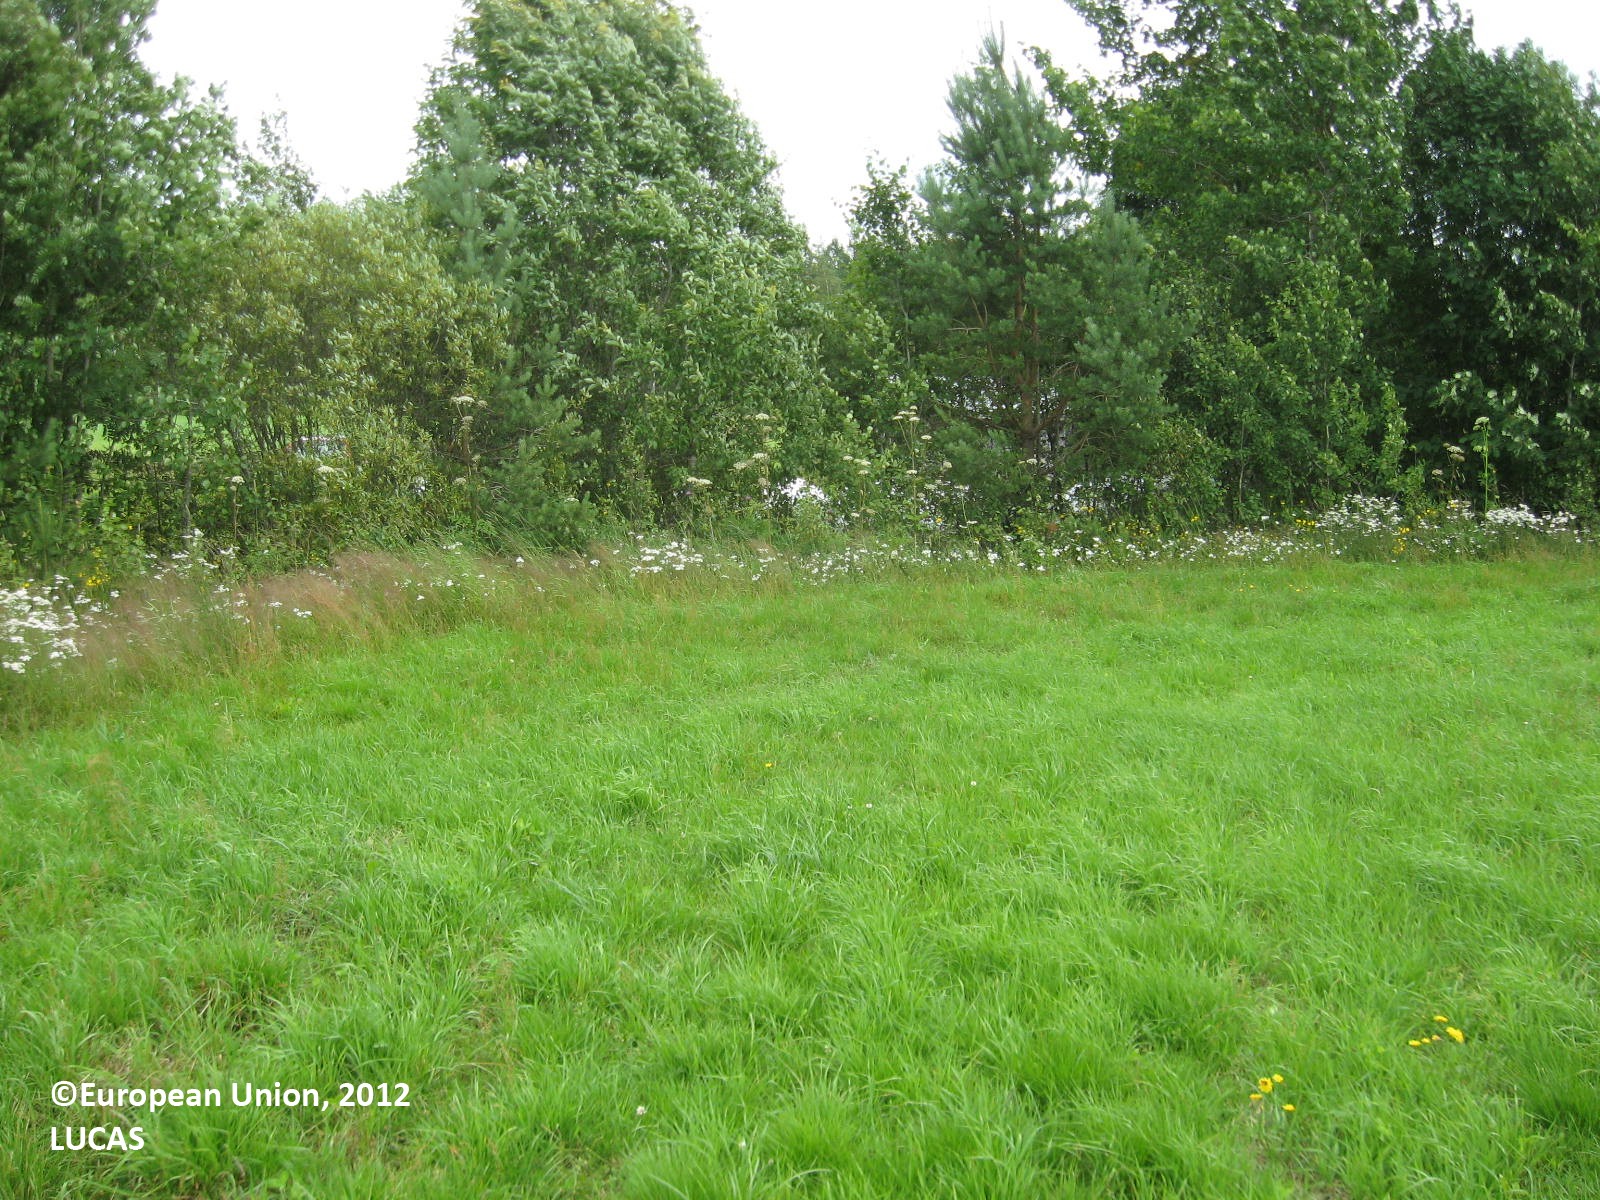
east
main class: Cropland
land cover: Temporary grasslands
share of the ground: > 75 %
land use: Agriculture (excluding fallow land and kitchen gardens)
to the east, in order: Temporary grasslands; Grass margins; Broadleaved woodland; Ditches and canals; Shruby margins; Temporary grasslands; Shruby margins; Temporary grasslands; Shruby margins; Ditches and canals; Pine dominated mixed woodland; Electric lines; Pine dominated mixed woodland; Grassland without tree/shrub cover; Artificial constructions in urban areas; Grassland without tree/shrub cover
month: July
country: FI
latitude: 62.1946
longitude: 22.7640
